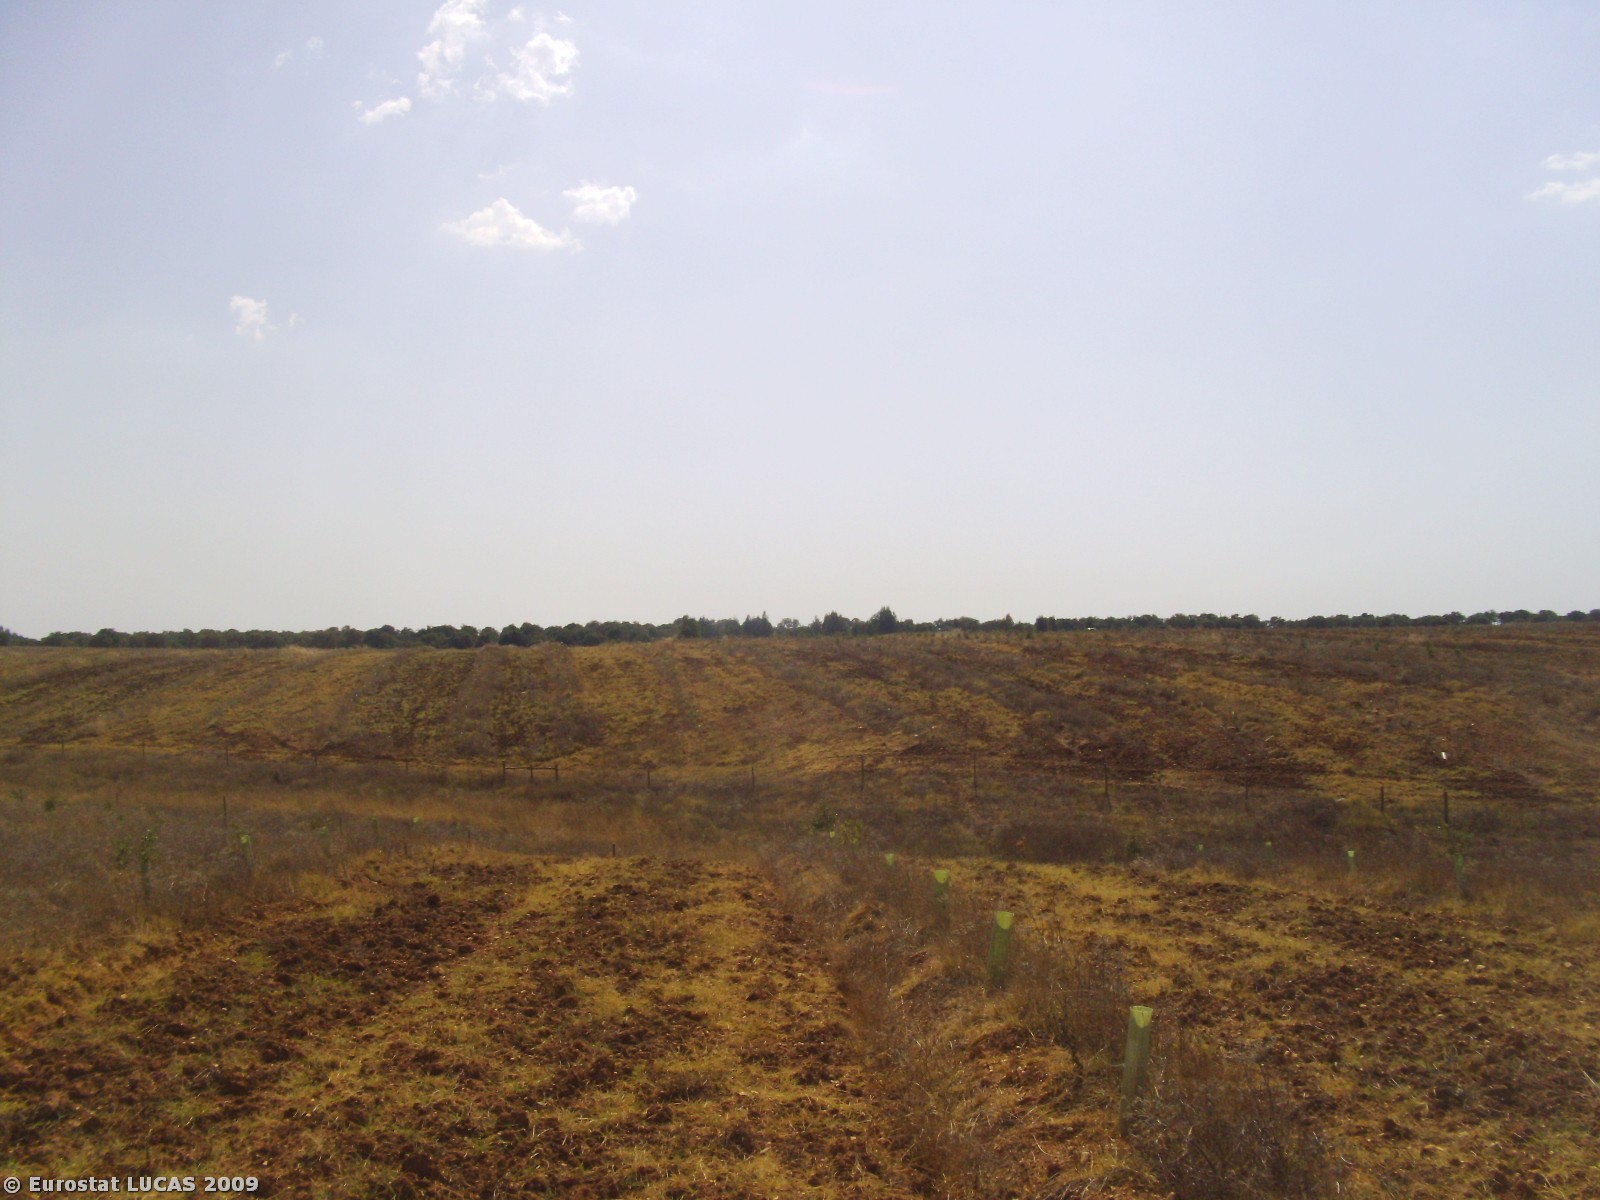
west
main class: Woodland
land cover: Broadleaved woodland
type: broadleaved evergreen forest
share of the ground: 10 - 25 %
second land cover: Spontaneously vegetated surfaces
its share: 50 - 75 %
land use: Forestry
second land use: Fallow land
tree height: < 5 m
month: August
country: PT
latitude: 37.9024
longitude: -8.2891
